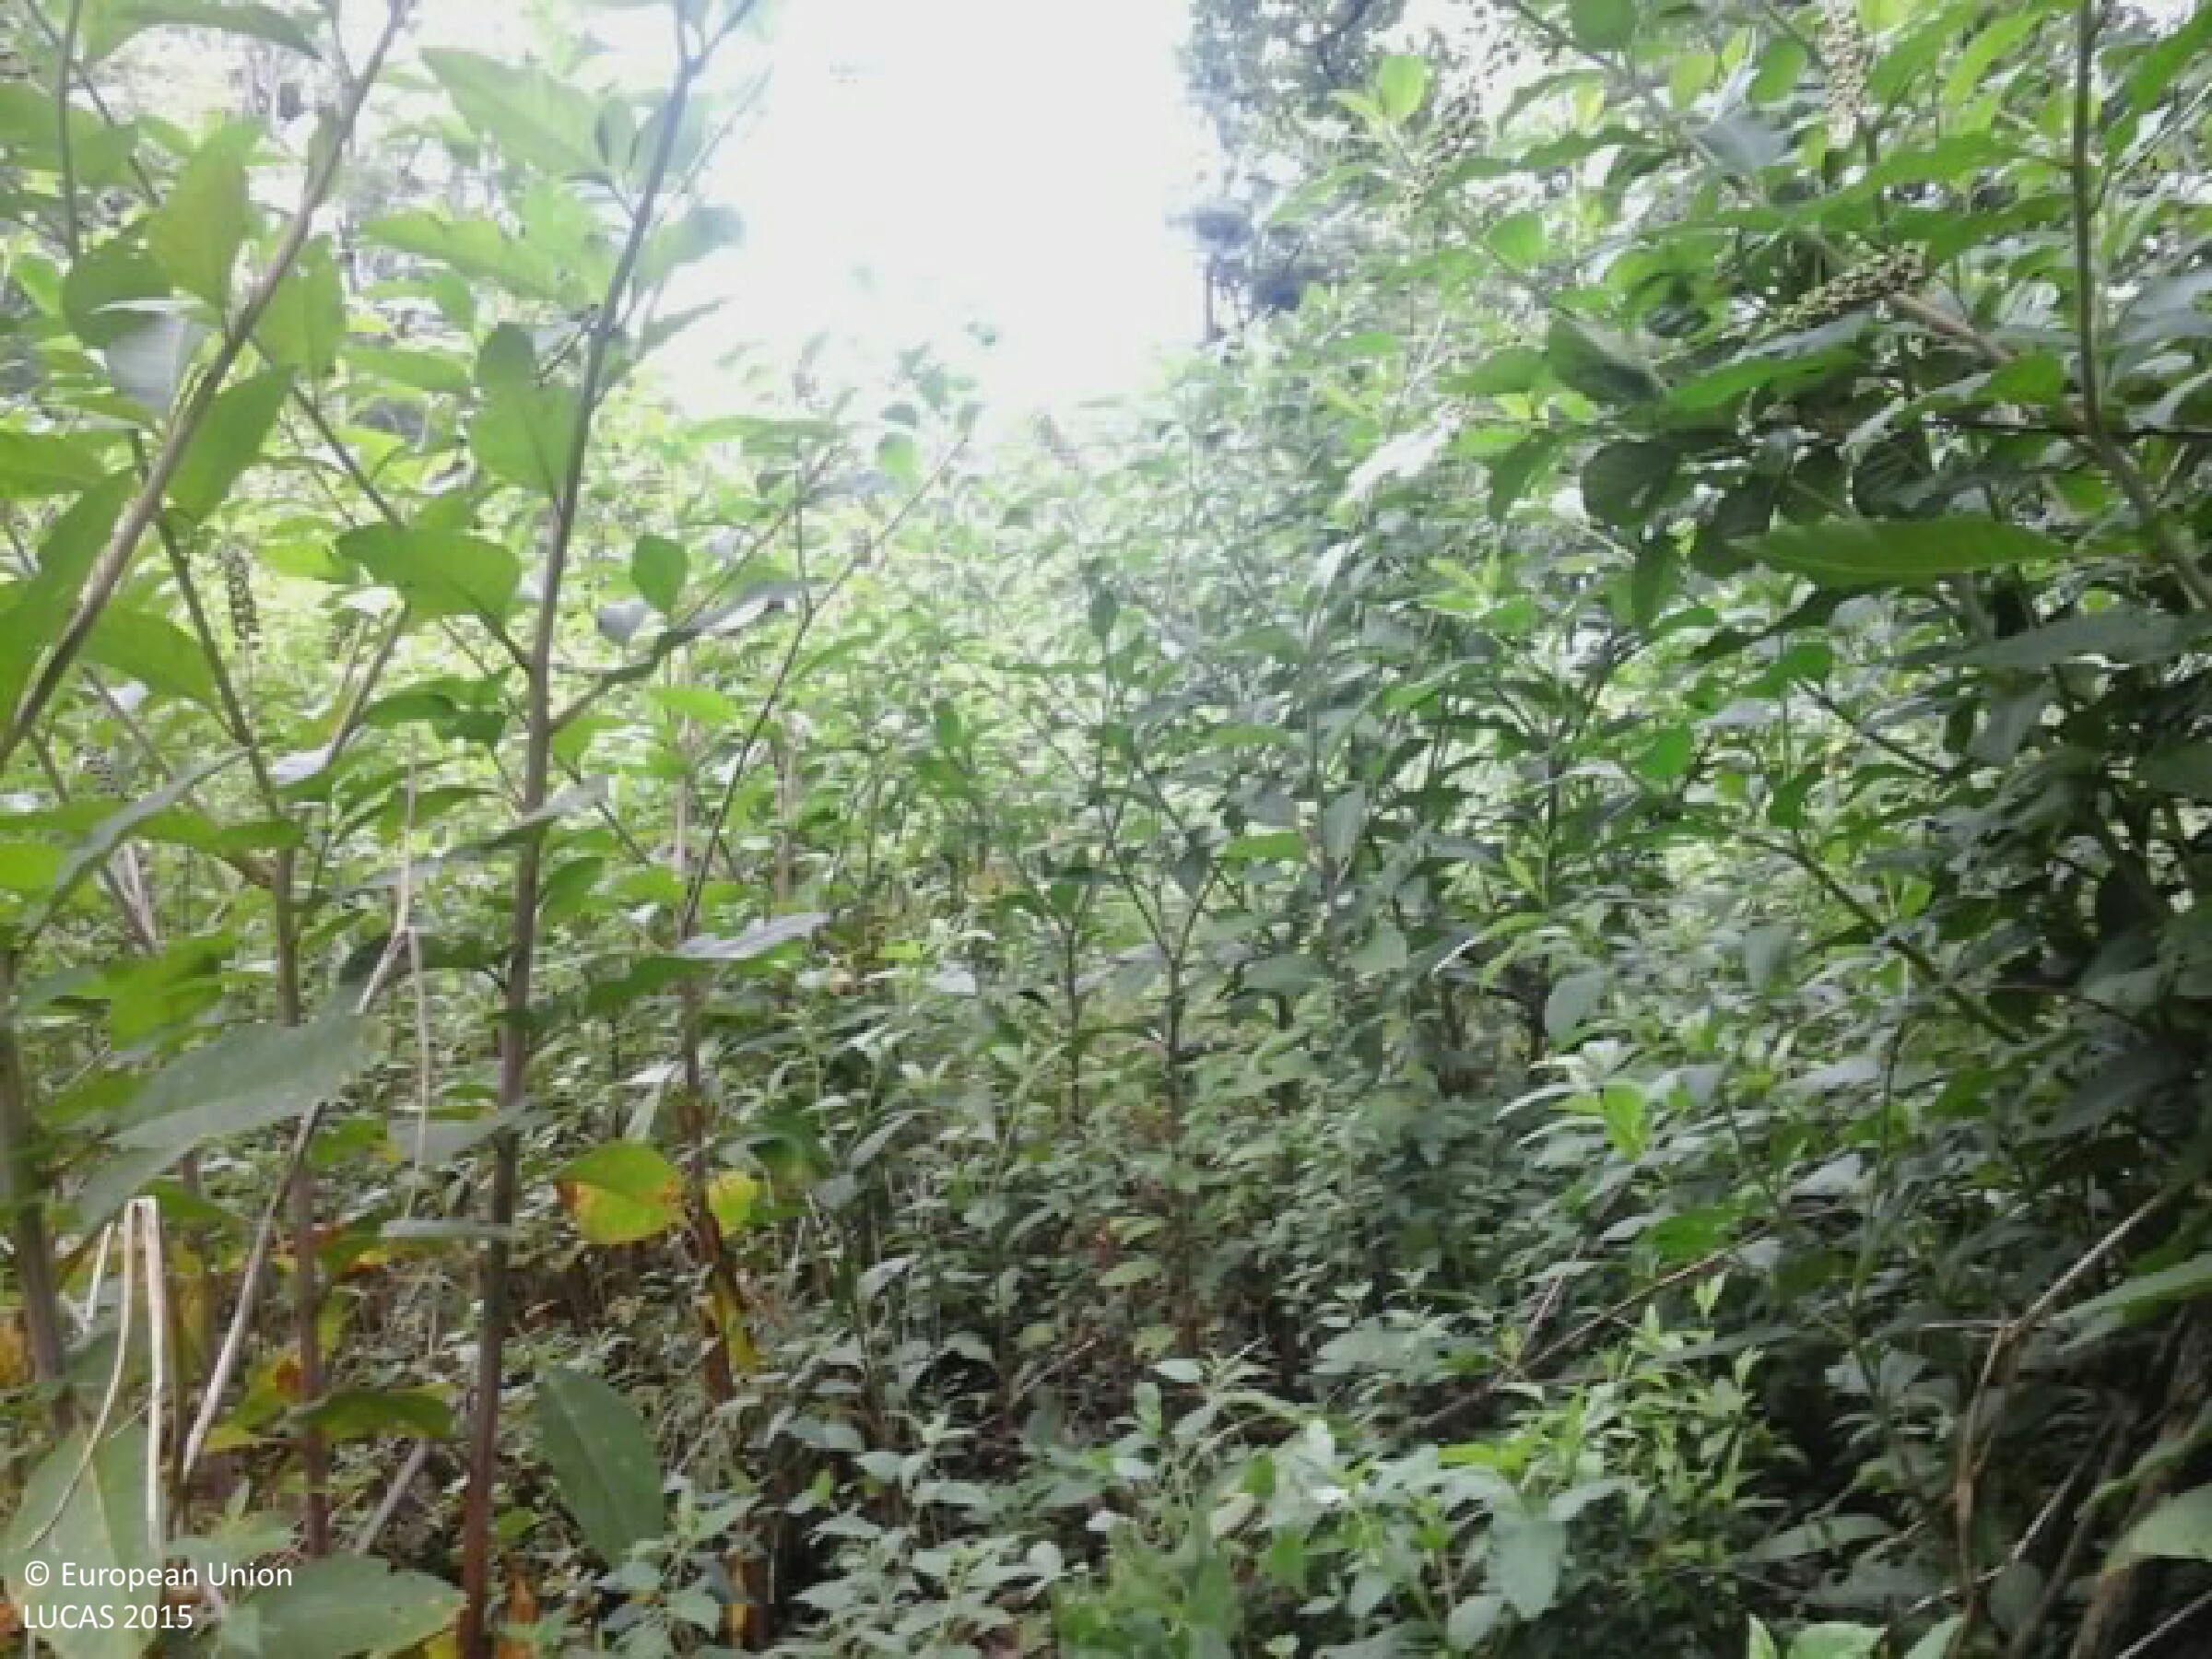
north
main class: Woodland
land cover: Broadleaved woodland
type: mire and swamp forests
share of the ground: 50 - 75 %
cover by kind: broadleaved forest trees 50 %, herbaceous plants 40 %, shrubs 10 %
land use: Semi-natural and natural areas not in use
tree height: > 5 m
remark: Temporary flooded
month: July
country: HU
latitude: 46.3945
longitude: 17.2474
